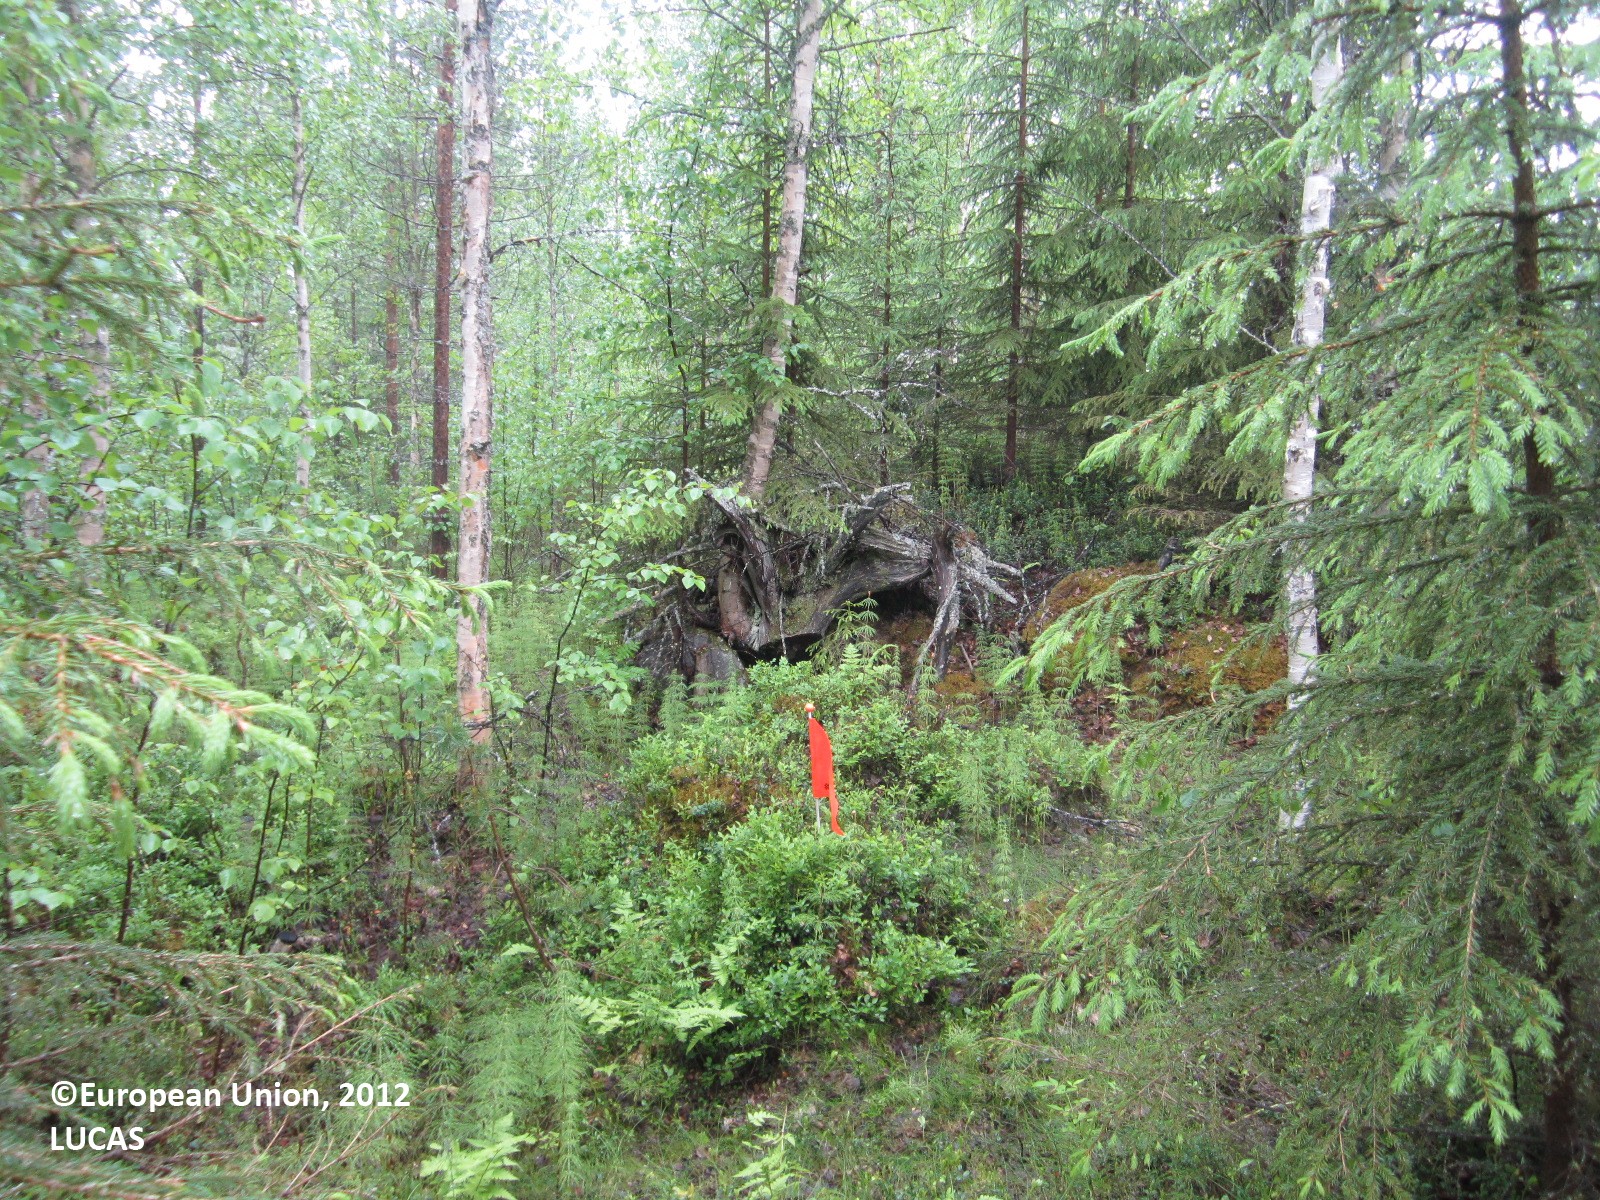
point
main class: Woodland
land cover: Spruce dominated mixed woodland
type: boreal forest
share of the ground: 50 - 75 %
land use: Forestry
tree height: > 5 m
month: June
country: FI
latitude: 64.3892
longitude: 29.4765
